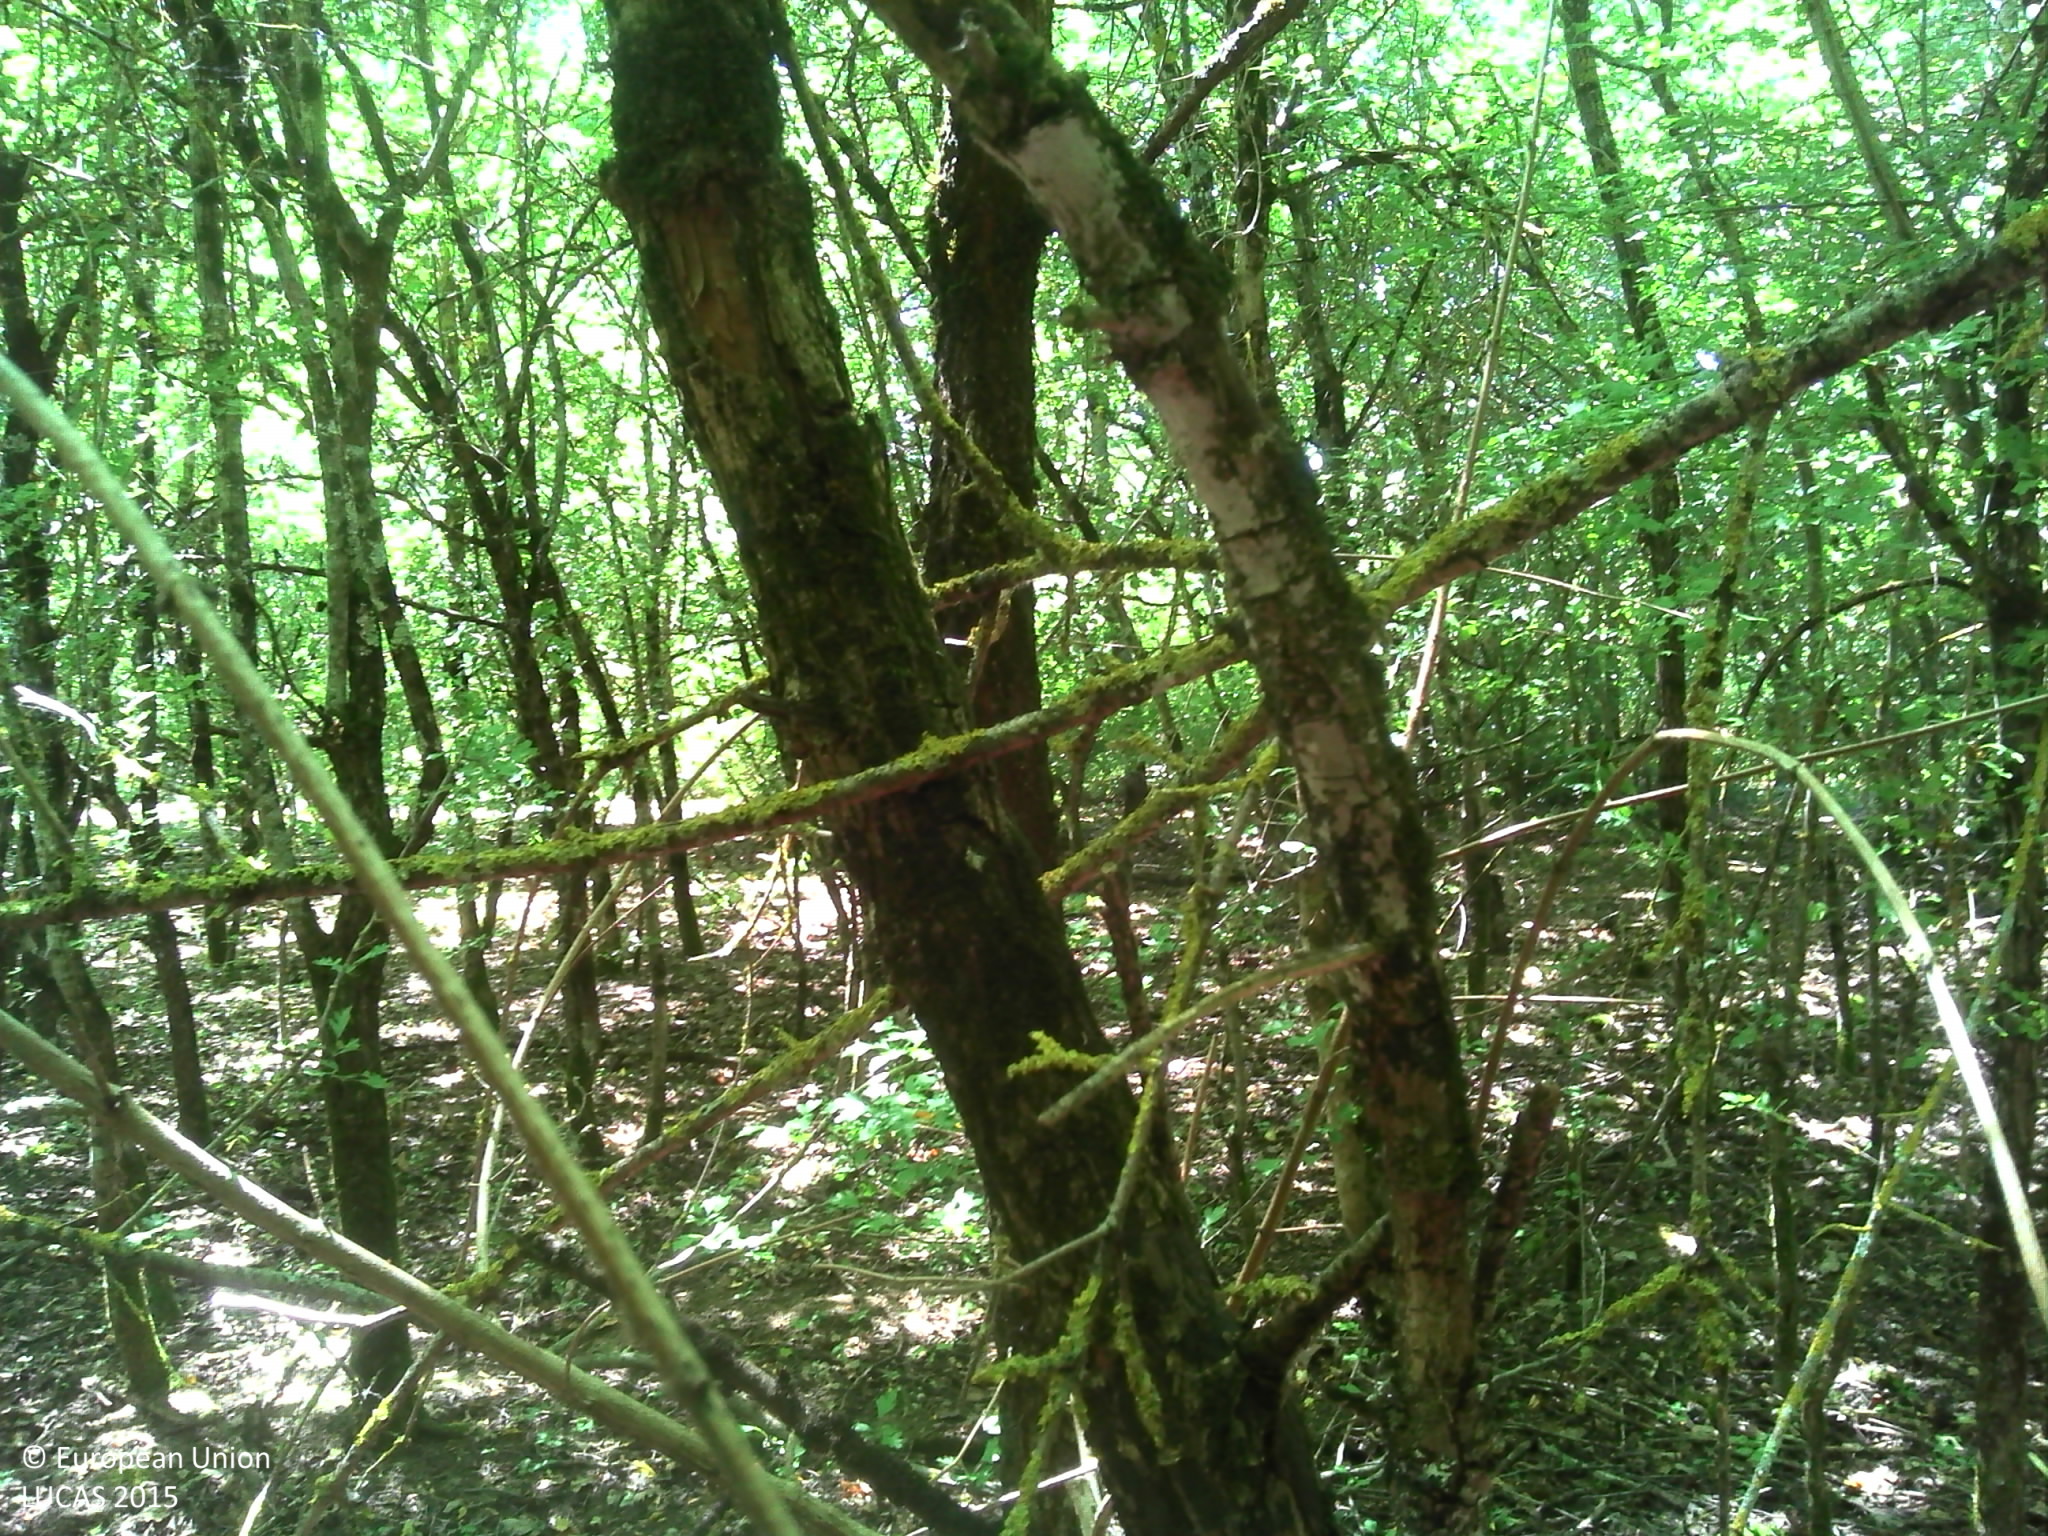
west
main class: Woodland
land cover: Broadleaved woodland
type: mesophytic deciduous forest
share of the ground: > 75 %
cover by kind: broadleaved forest trees 100 %
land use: Forestry
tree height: > 5 m
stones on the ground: < 10 %
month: June
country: FR
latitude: 43.6056
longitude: 1.9891
